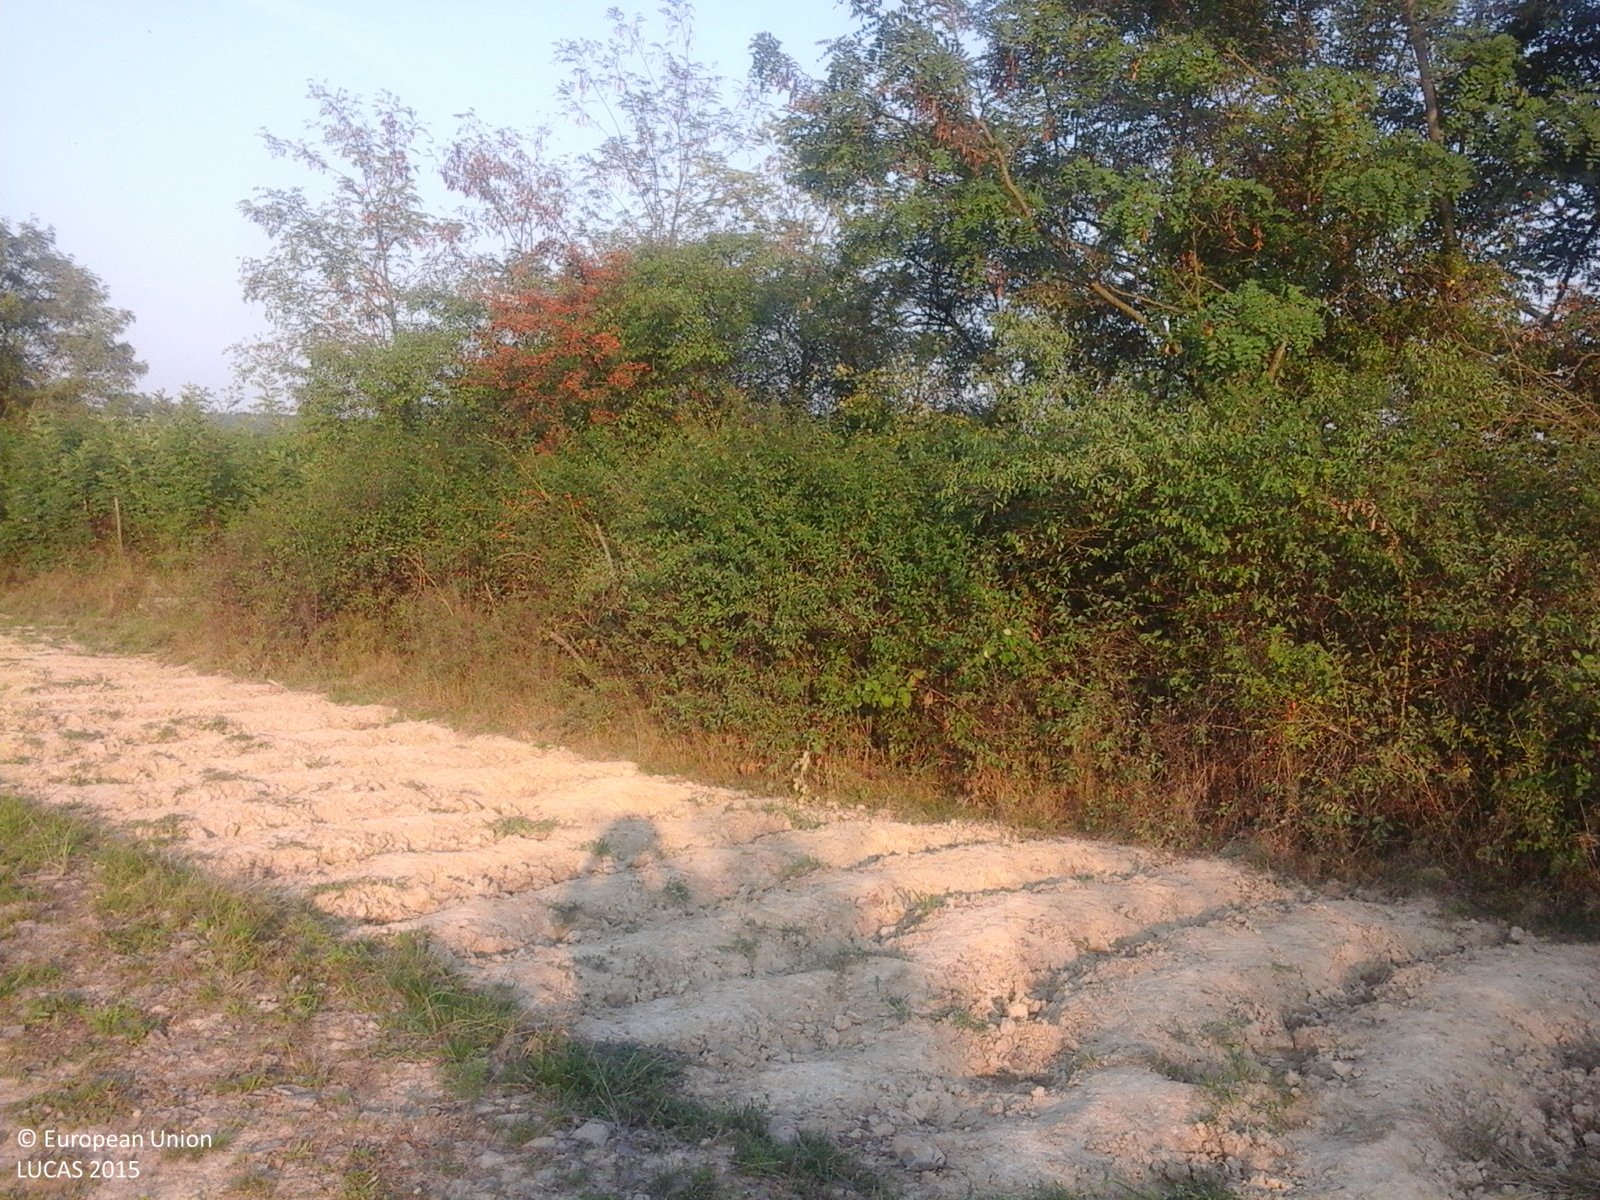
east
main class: Artificial land
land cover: Other artificial areas
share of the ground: > 75 %
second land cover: Grassland without tree/shrub cover
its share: > 75 %
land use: Energy production
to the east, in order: Artificial constructions in urban areas; Grassland without tree/shrub cover; Fences; Lines of trees; Ditches and canals; Lines of trees; Tracks; Abandoned hedges; Grassland without tree/shrub cover; Maize; Grassland without tree/shrub cover
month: August
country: RO
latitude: 46.4251
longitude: 22.1079
